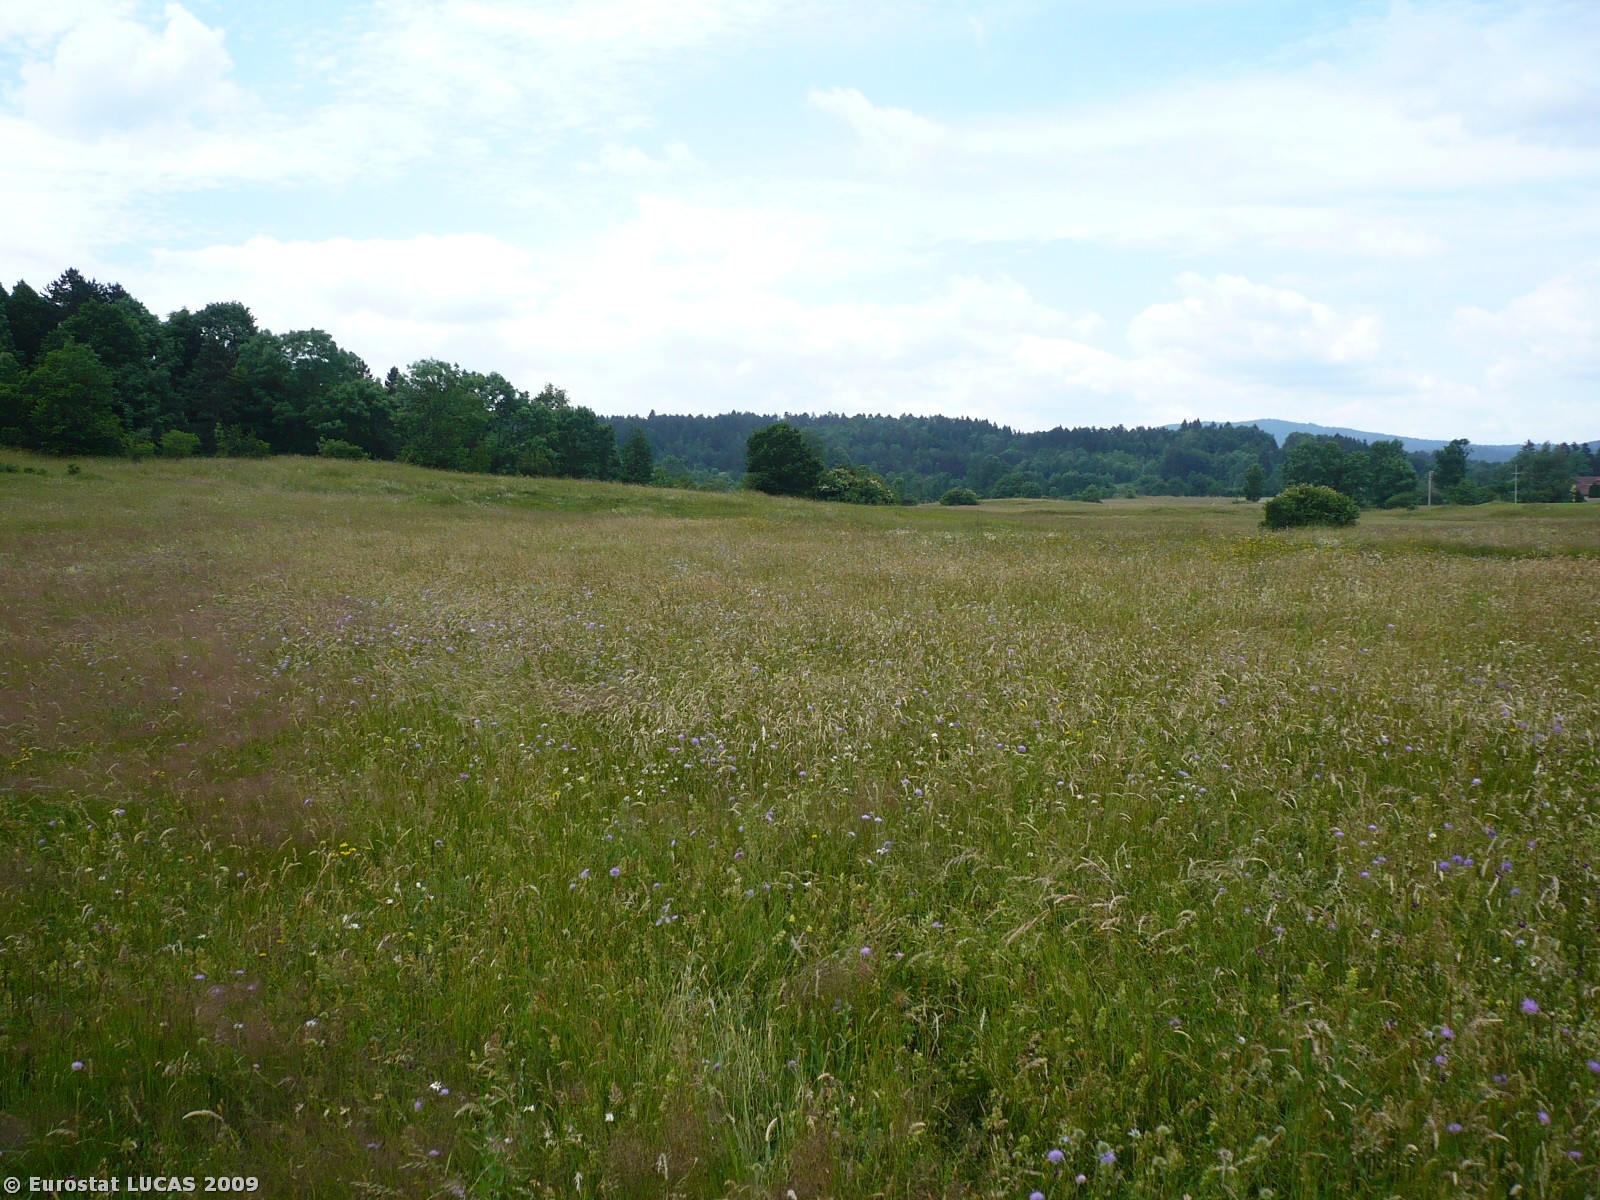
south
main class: Grassland
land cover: Grassland without tree/shrub cover
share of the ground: > 75 %
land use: Agriculture (excluding fallow land and kitchen gardens)
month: June
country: SI
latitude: 45.7457
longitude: 14.1989
